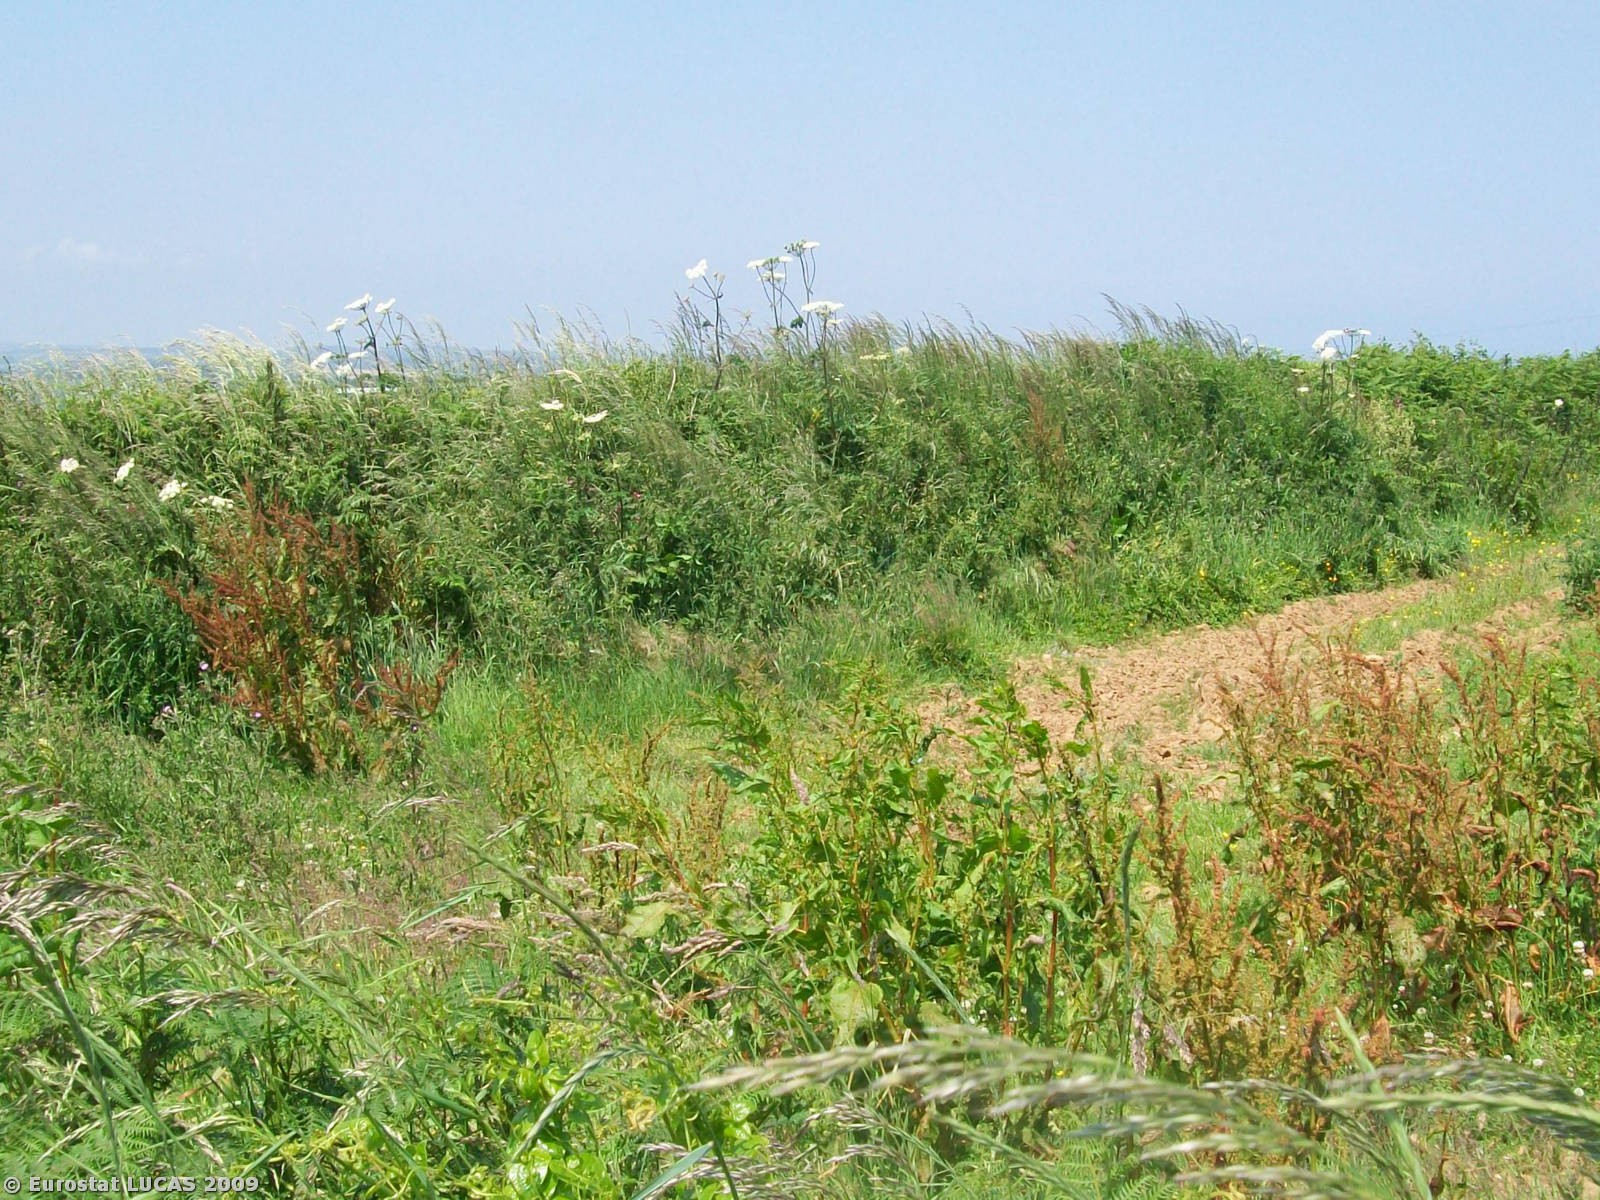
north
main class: Grassland
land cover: Spontaneously vegetated surfaces
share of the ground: 25 - 50 %
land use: Fallow land
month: June
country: GB
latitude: 50.0665
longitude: -5.1080
